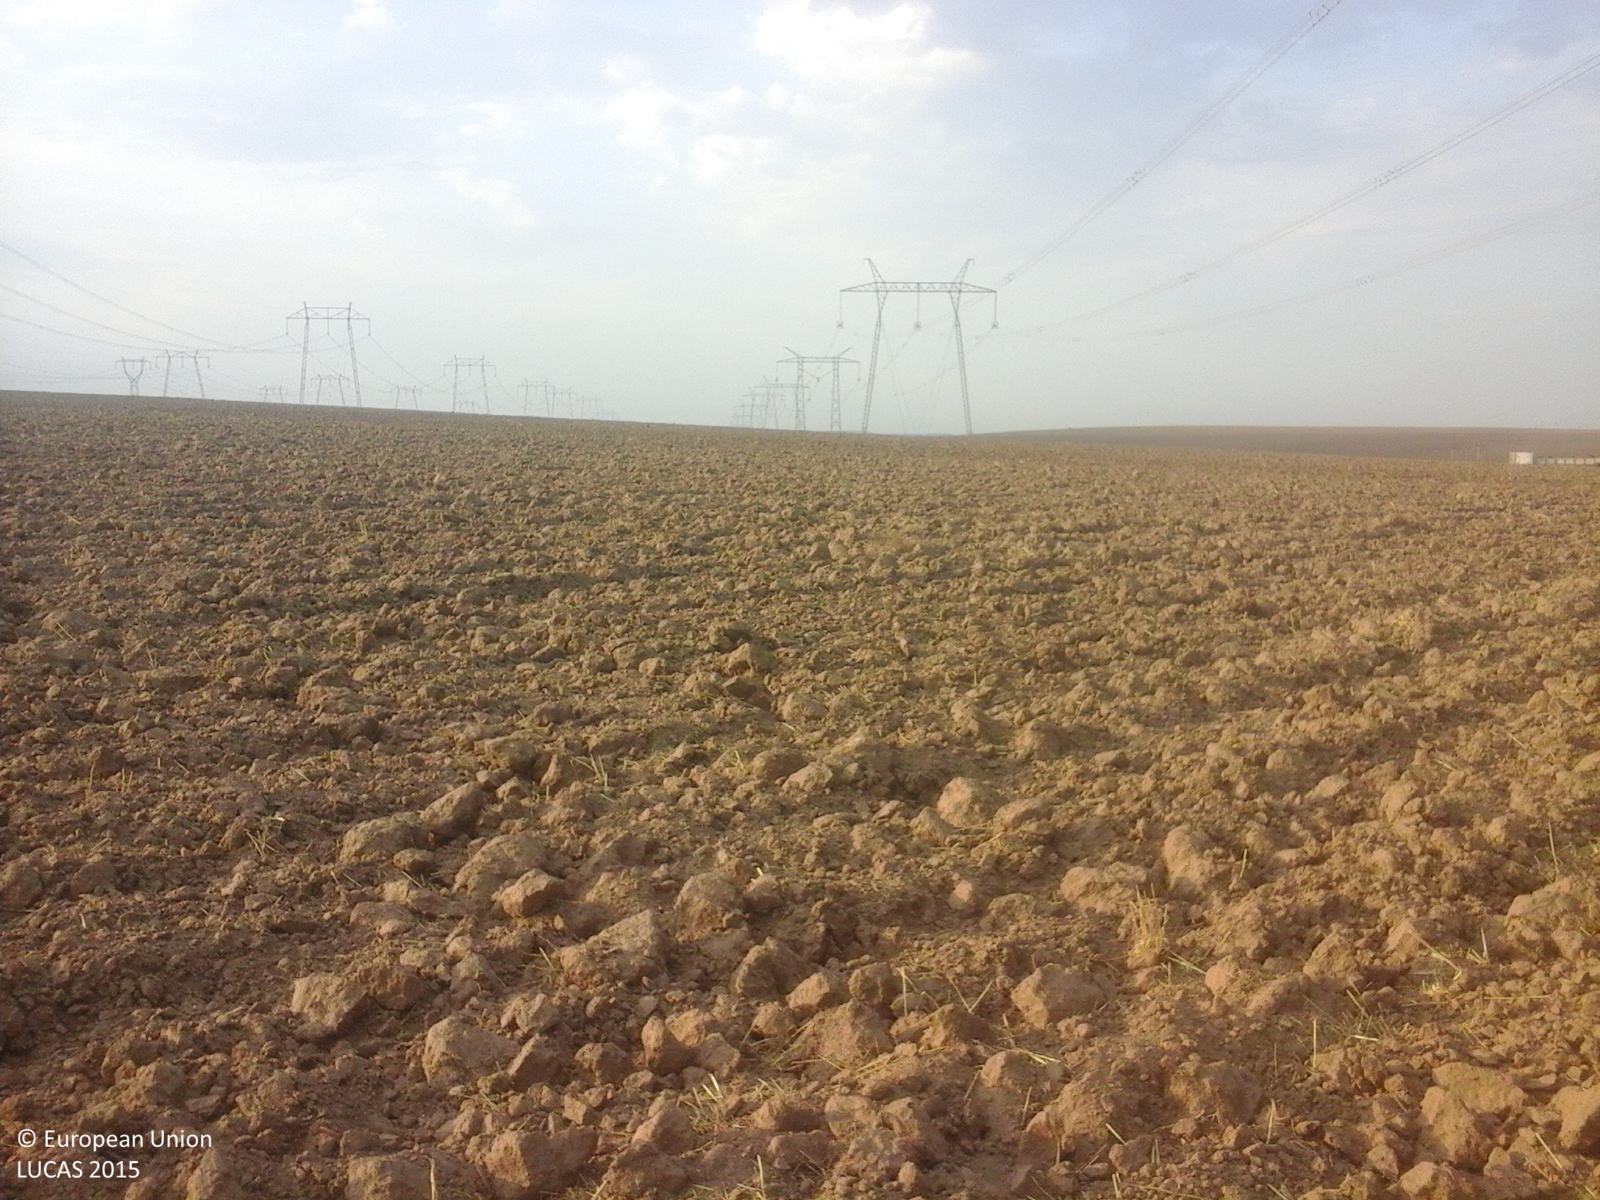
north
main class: Cropland
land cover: Common wheat
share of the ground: < 10 %
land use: Agriculture (excluding fallow land and kitchen gardens)
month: August
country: RO
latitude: 44.4111
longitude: 28.1572
